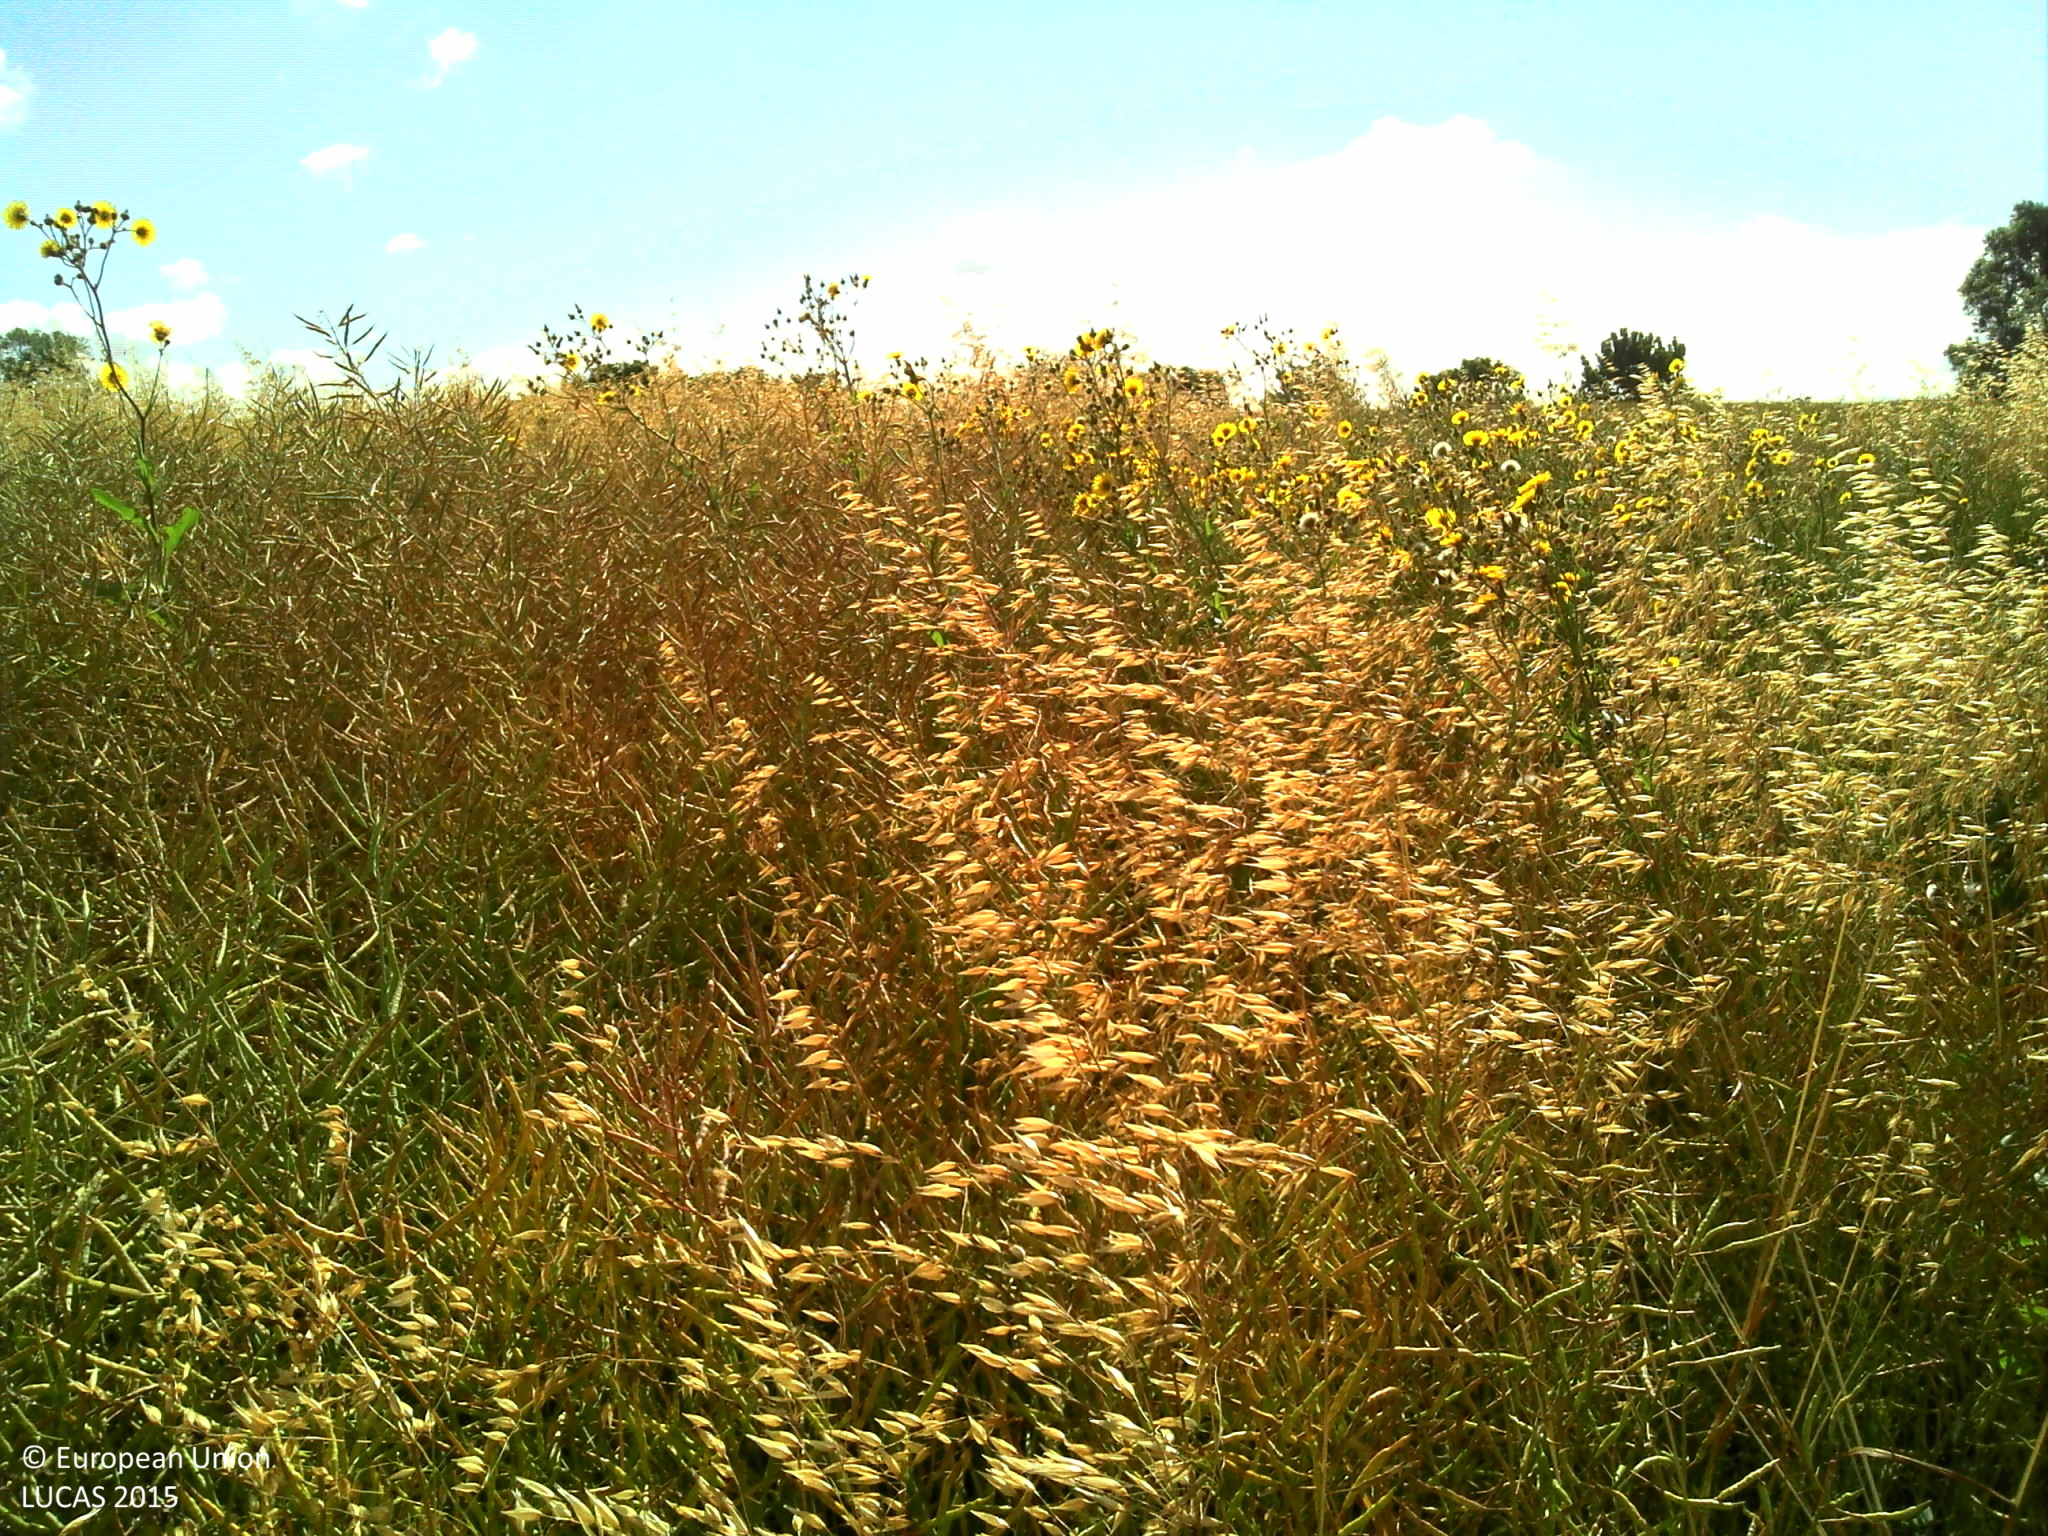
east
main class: Cropland
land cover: Rape and turnip rape
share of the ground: > 75 %
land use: Agriculture (excluding fallow land and kitchen gardens)
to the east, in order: Rape and turnip rape; Grass margins; Tracks; Grass margins; Sugar beet; Grass margins; Paved roads, cycling and walking lanes; Grass margins; Ditches and canals; Grass margins; Other root crops
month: July
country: FR
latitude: 50.9203
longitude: 2.3473
